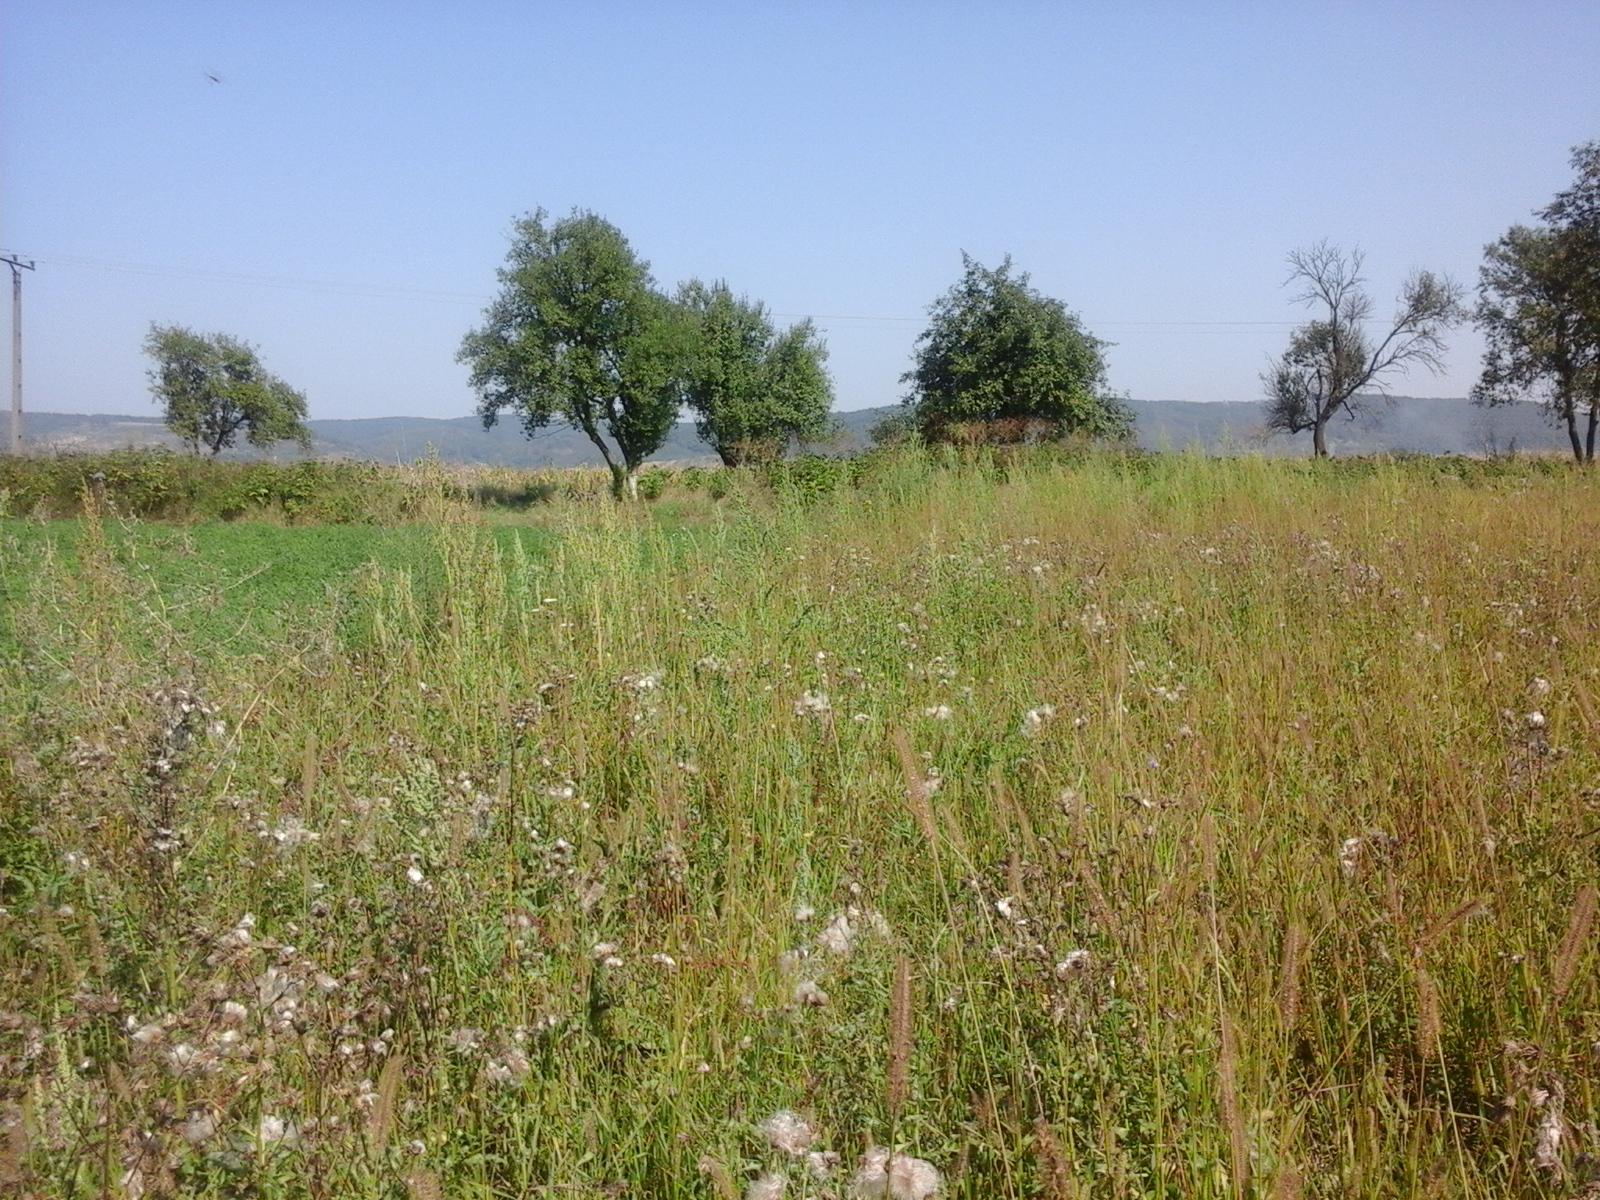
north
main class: Grassland
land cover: Spontaneously vegetated surfaces
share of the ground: > 75 %
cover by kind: herbaceous plants 100 %
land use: Agriculture (excluding fallow land and kitchen gardens)
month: August
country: RO
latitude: 45.9395
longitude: 22.6783
